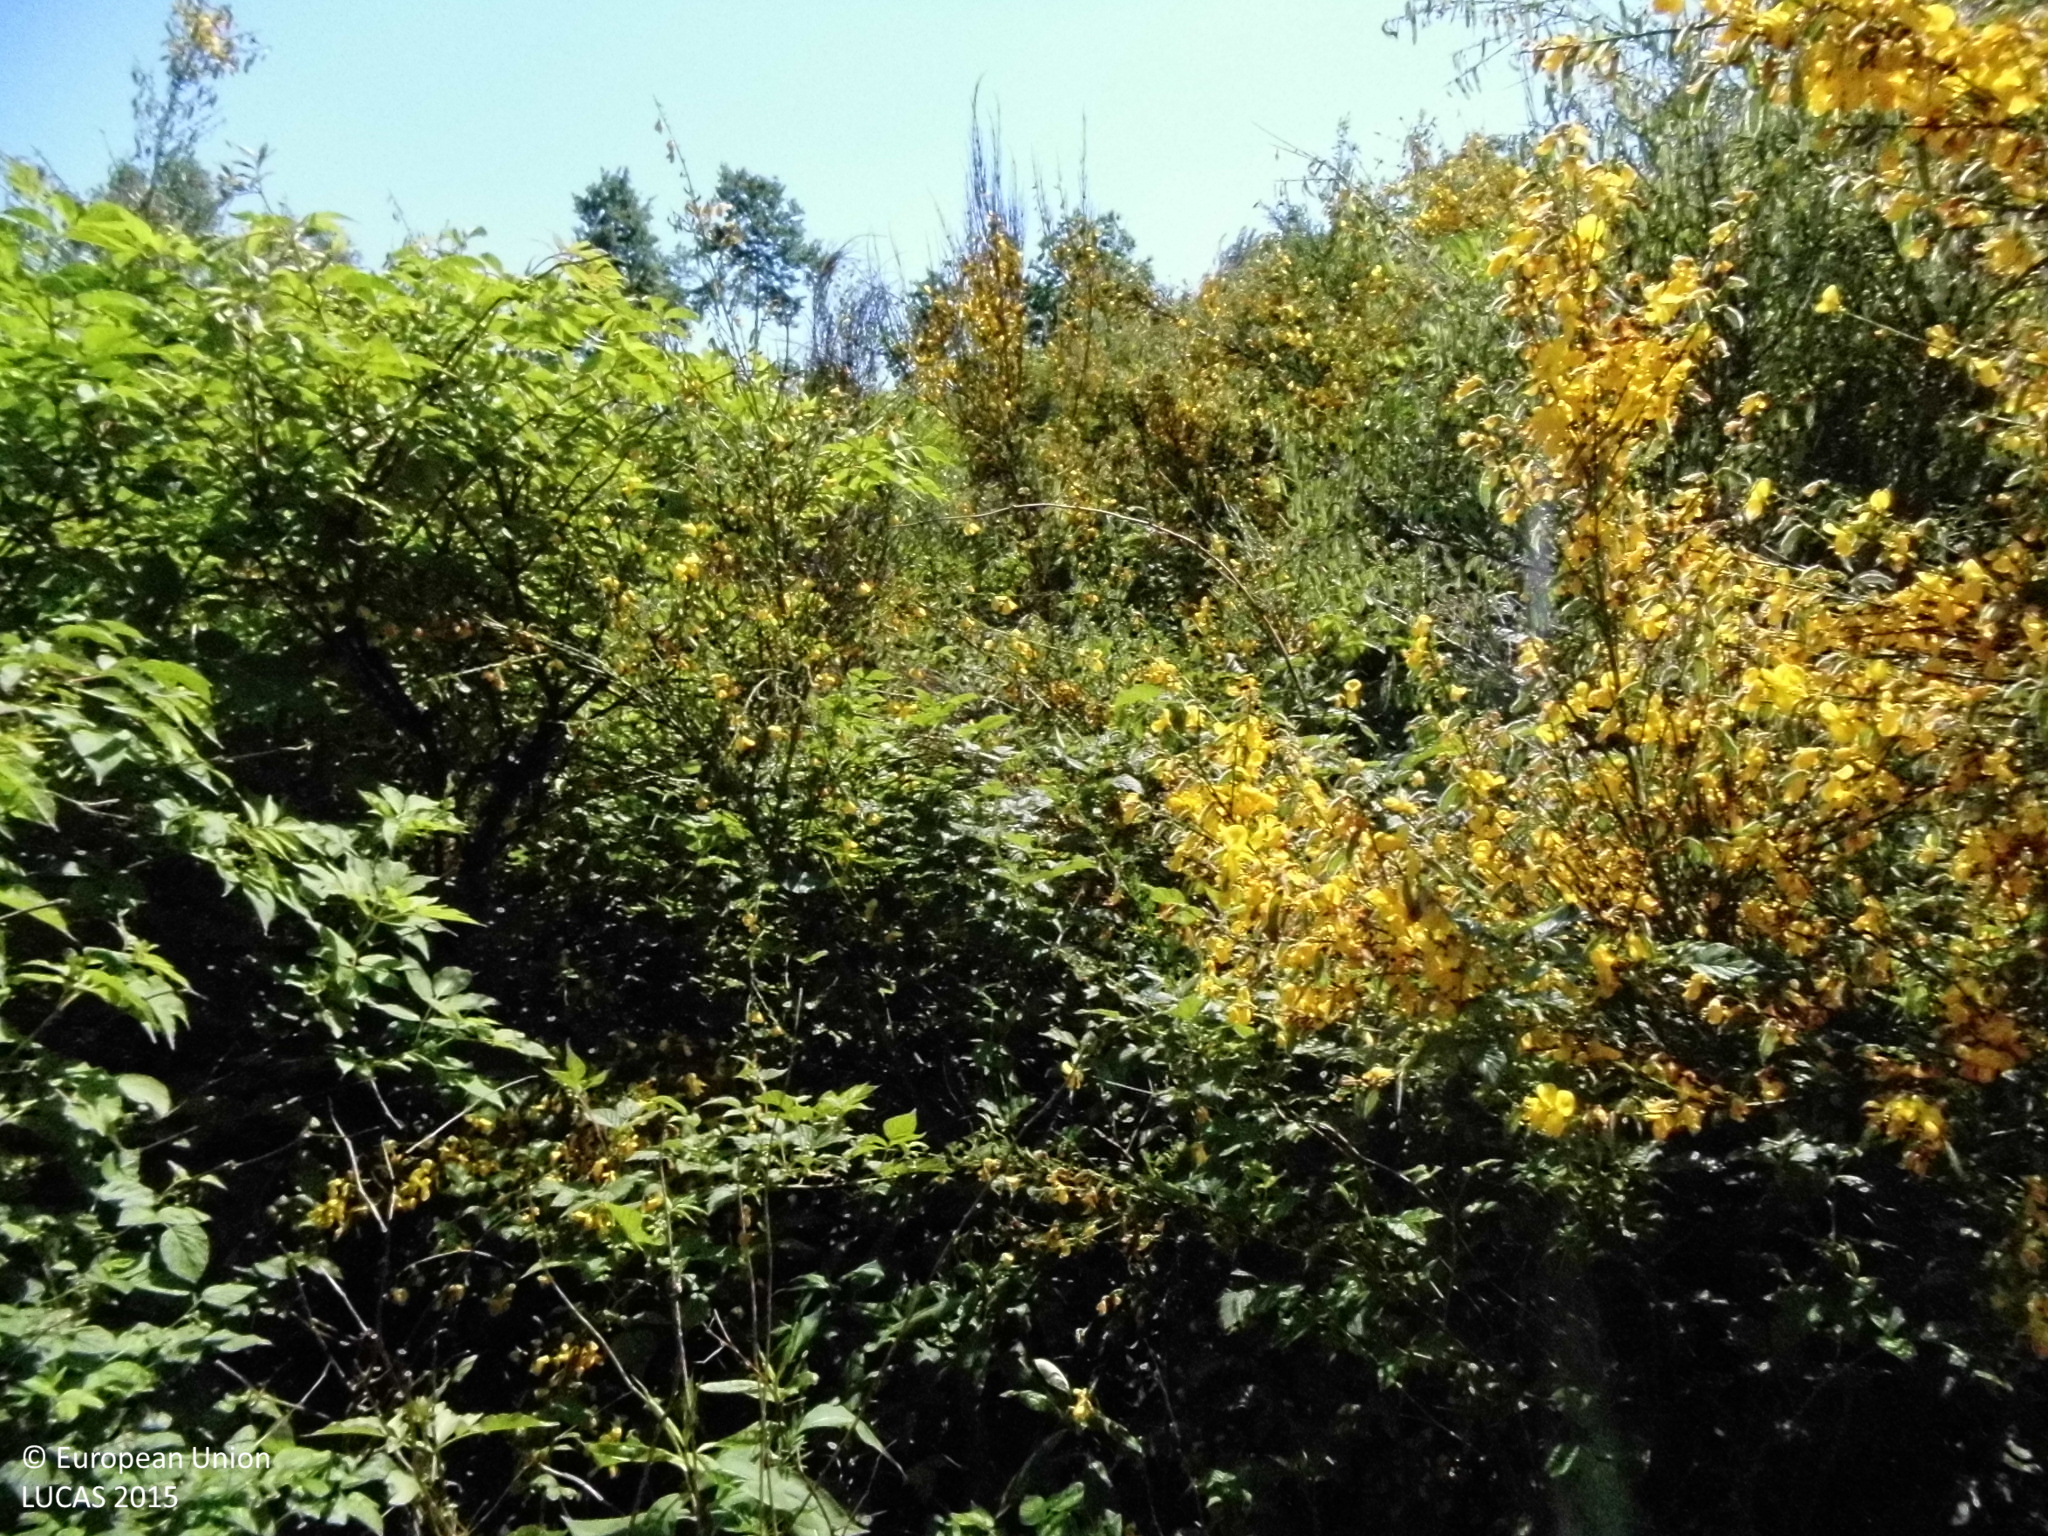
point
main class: Shrubland
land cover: Shrubland with sparse tree cover
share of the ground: > 75 %
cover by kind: shrubs 85 %, herbaceous plants 10 %, broadleaved forest trees 5 %
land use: Semi-natural and natural areas not in use
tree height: < 5 m
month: June
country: DE
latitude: 50.8516
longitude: 8.0828
